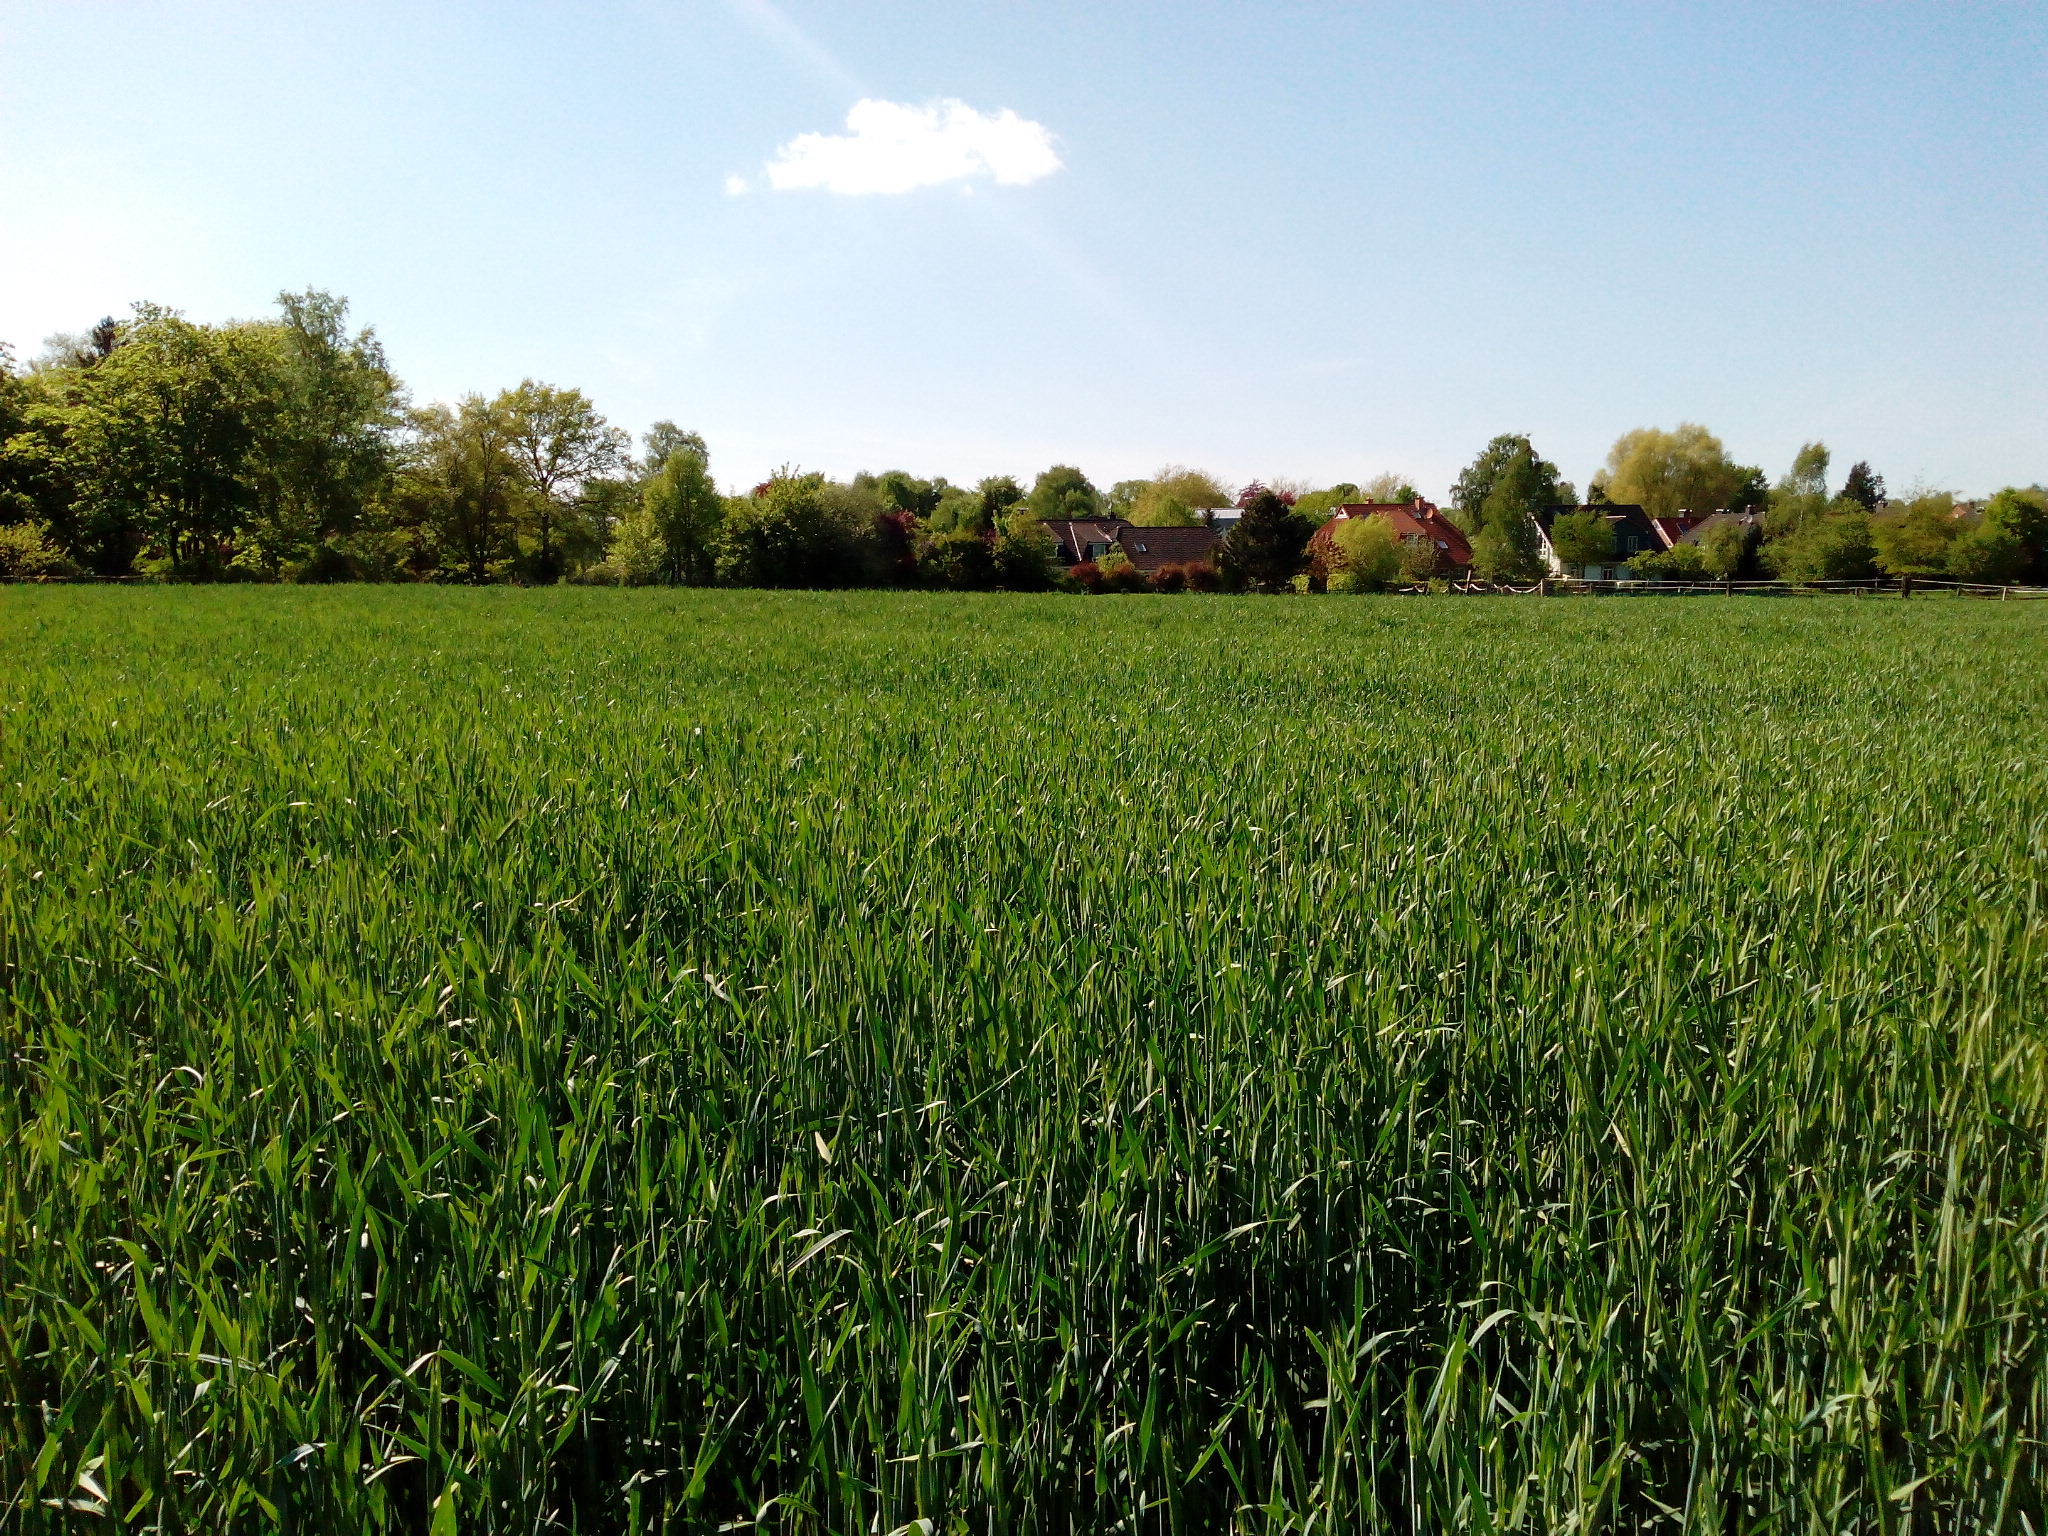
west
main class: Cropland
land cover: Rye
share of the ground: > 75 %
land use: Agriculture (excluding fallow land and kitchen gardens)
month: May
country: DE
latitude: 52.4852
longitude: 9.8675
